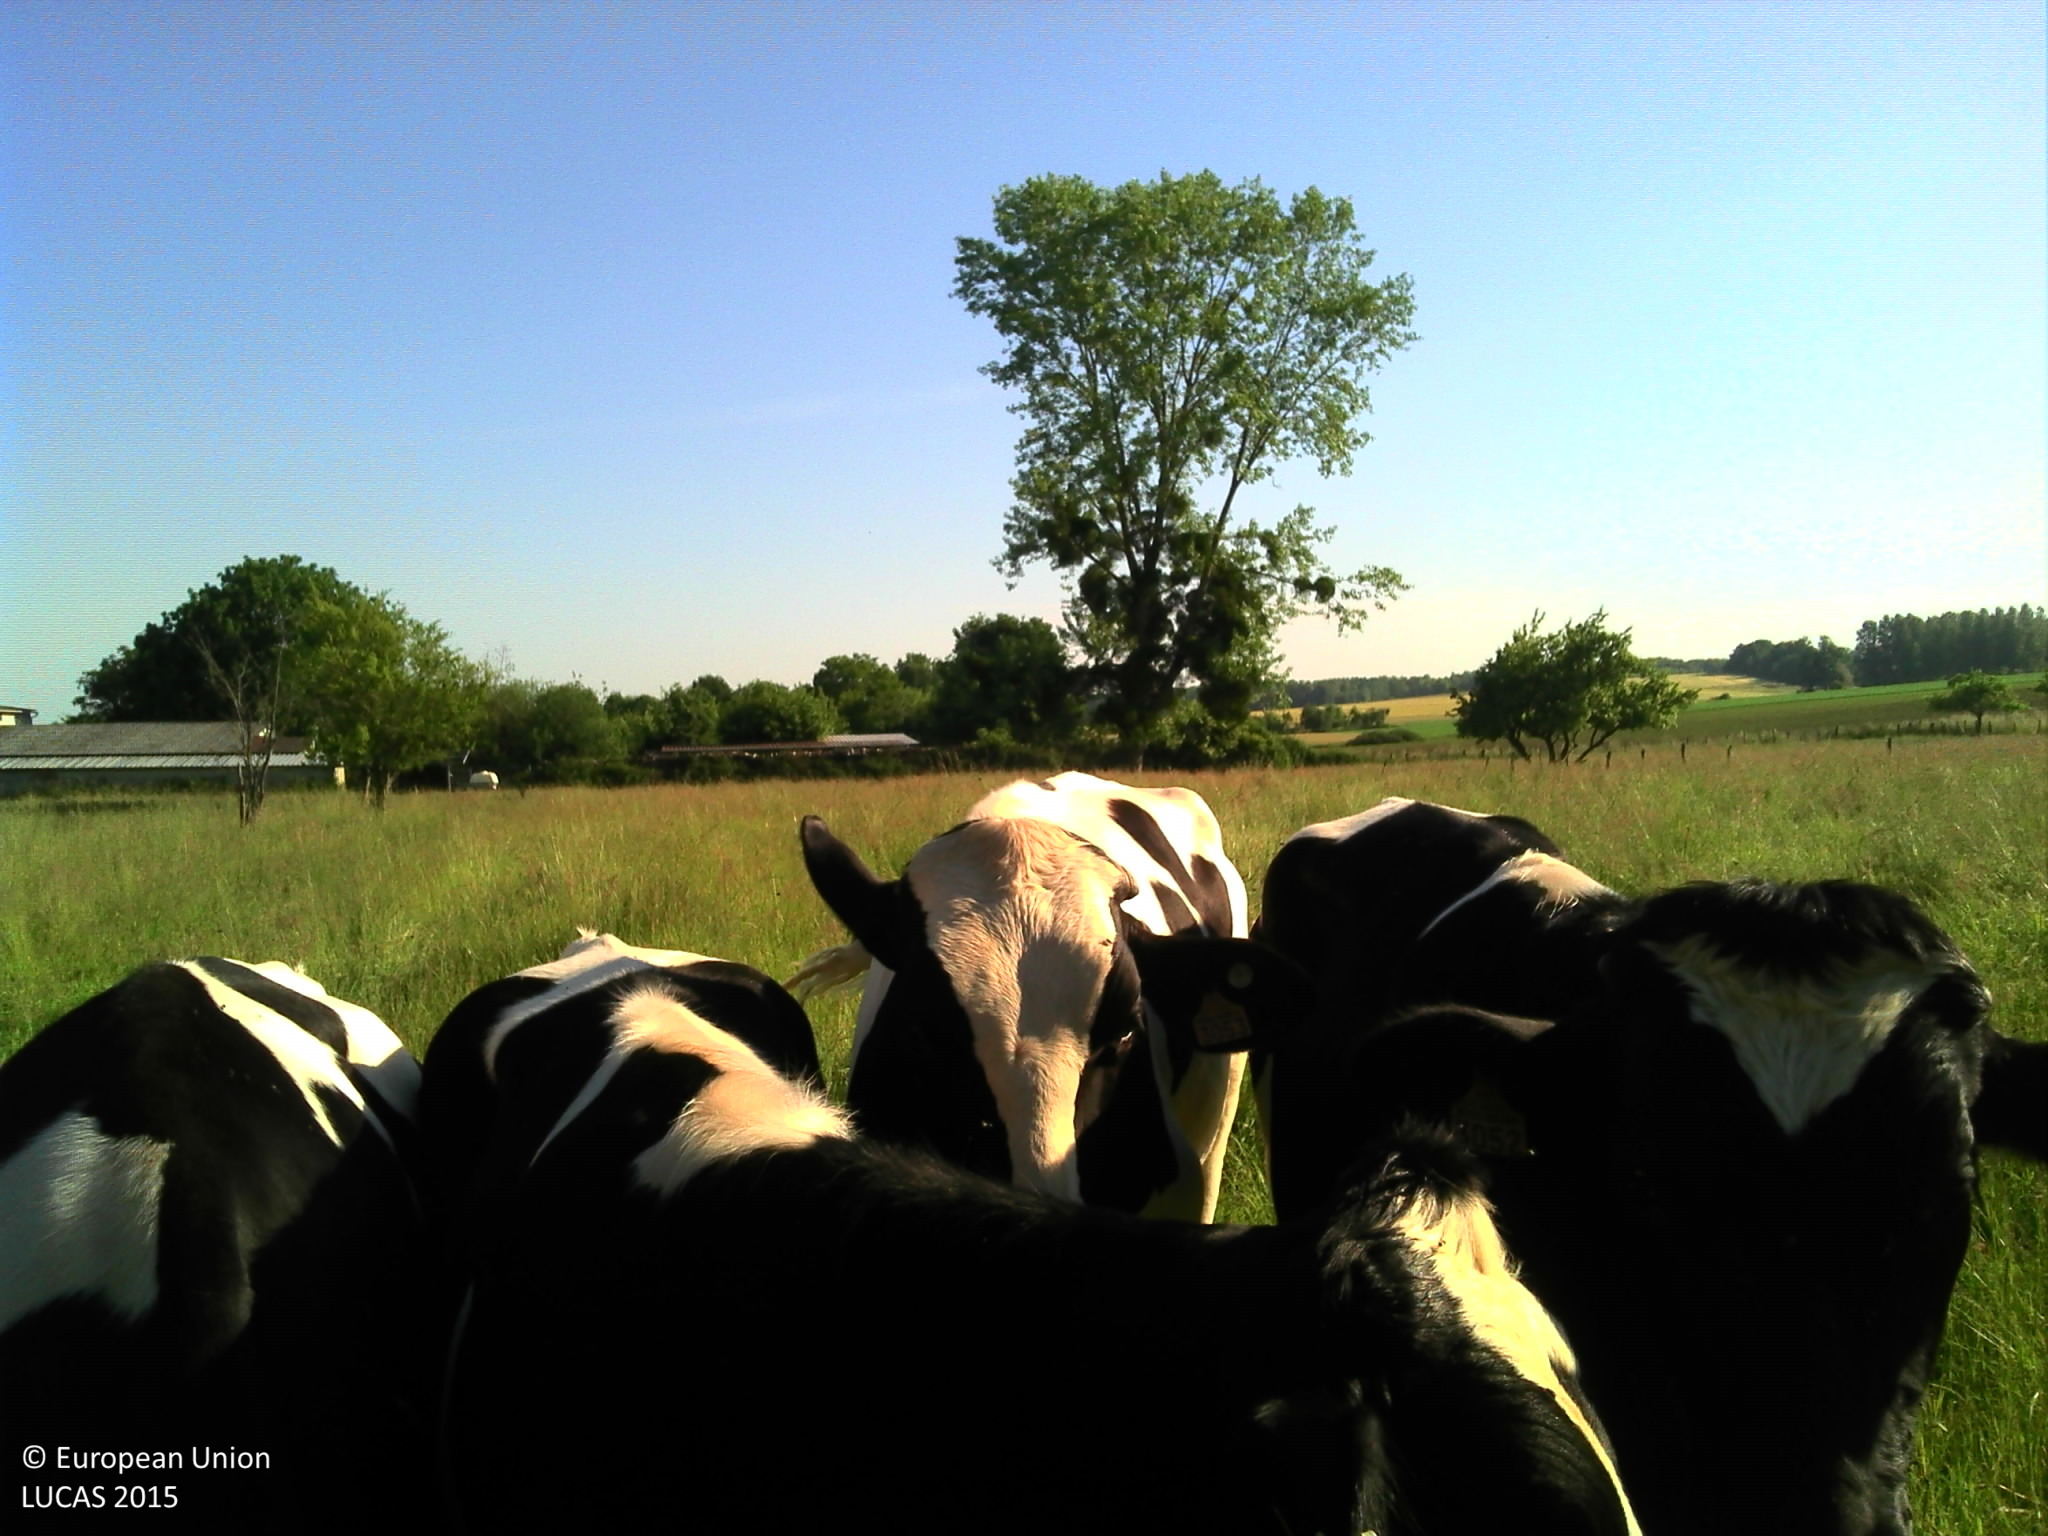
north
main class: Grassland
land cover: Grassland with sparse tree/shrub cover
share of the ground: > 75 %
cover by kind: herbaceous plants 90 %, broadleaved forest trees 5 %, shrubs 5 %
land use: Agriculture (excluding fallow land and kitchen gardens)
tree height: > 5 m
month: June
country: FR
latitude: 48.4560
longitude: 4.6836
